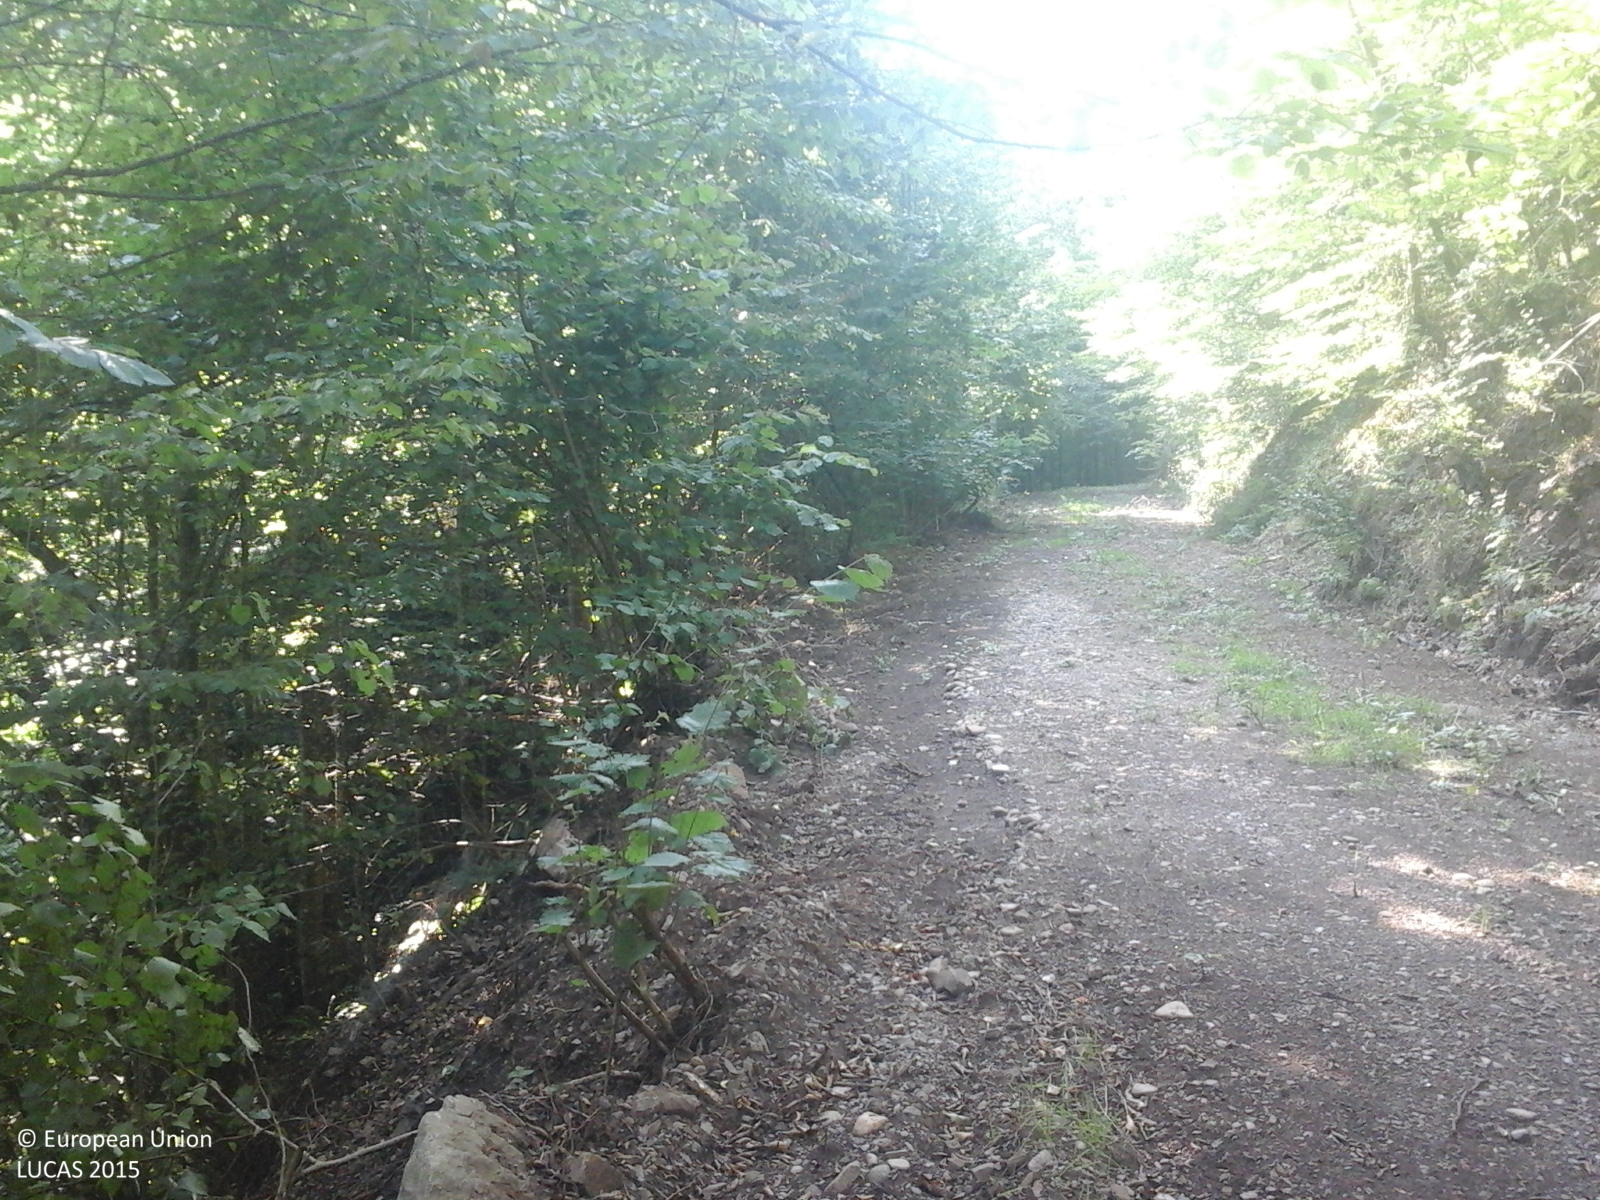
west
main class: Woodland
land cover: Broadleaved woodland
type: beech forest
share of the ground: > 75 %
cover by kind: broadleaved forest trees 100 %
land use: Forestry
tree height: > 5 m
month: August
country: RO
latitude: 46.4340
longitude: 22.3475
